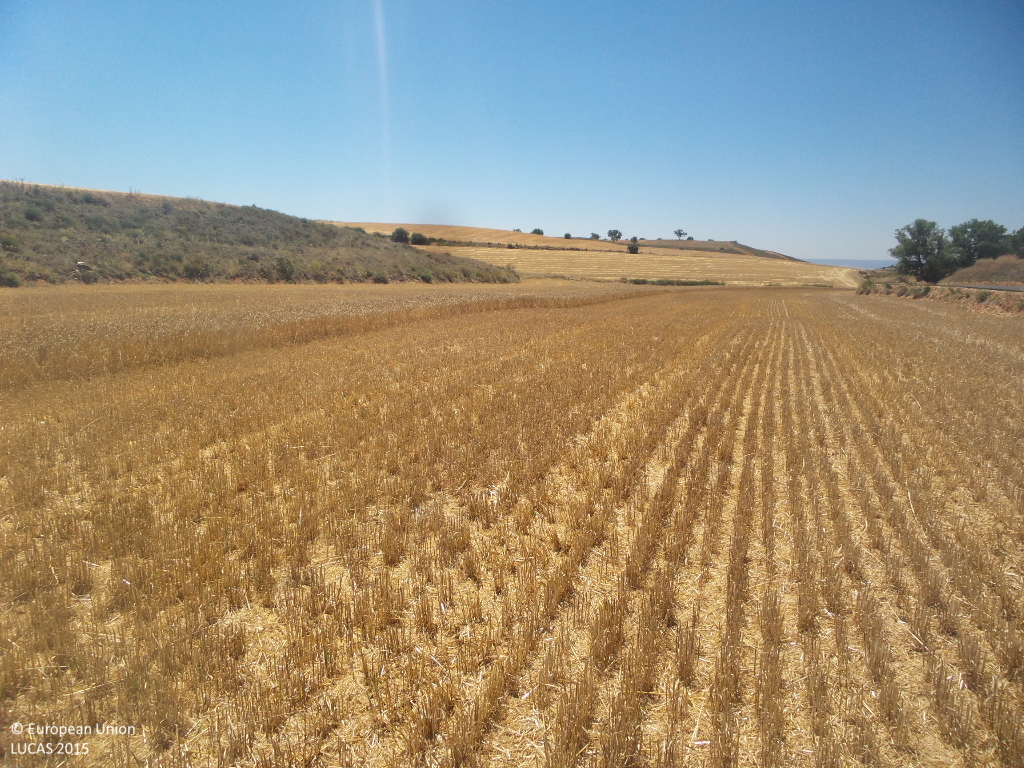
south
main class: Cropland
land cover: Barley
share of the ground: < 10 %
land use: Agriculture (excluding fallow land and kitchen gardens)
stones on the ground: < 10 %
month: July
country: ES
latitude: 41.3968
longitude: -2.0983
